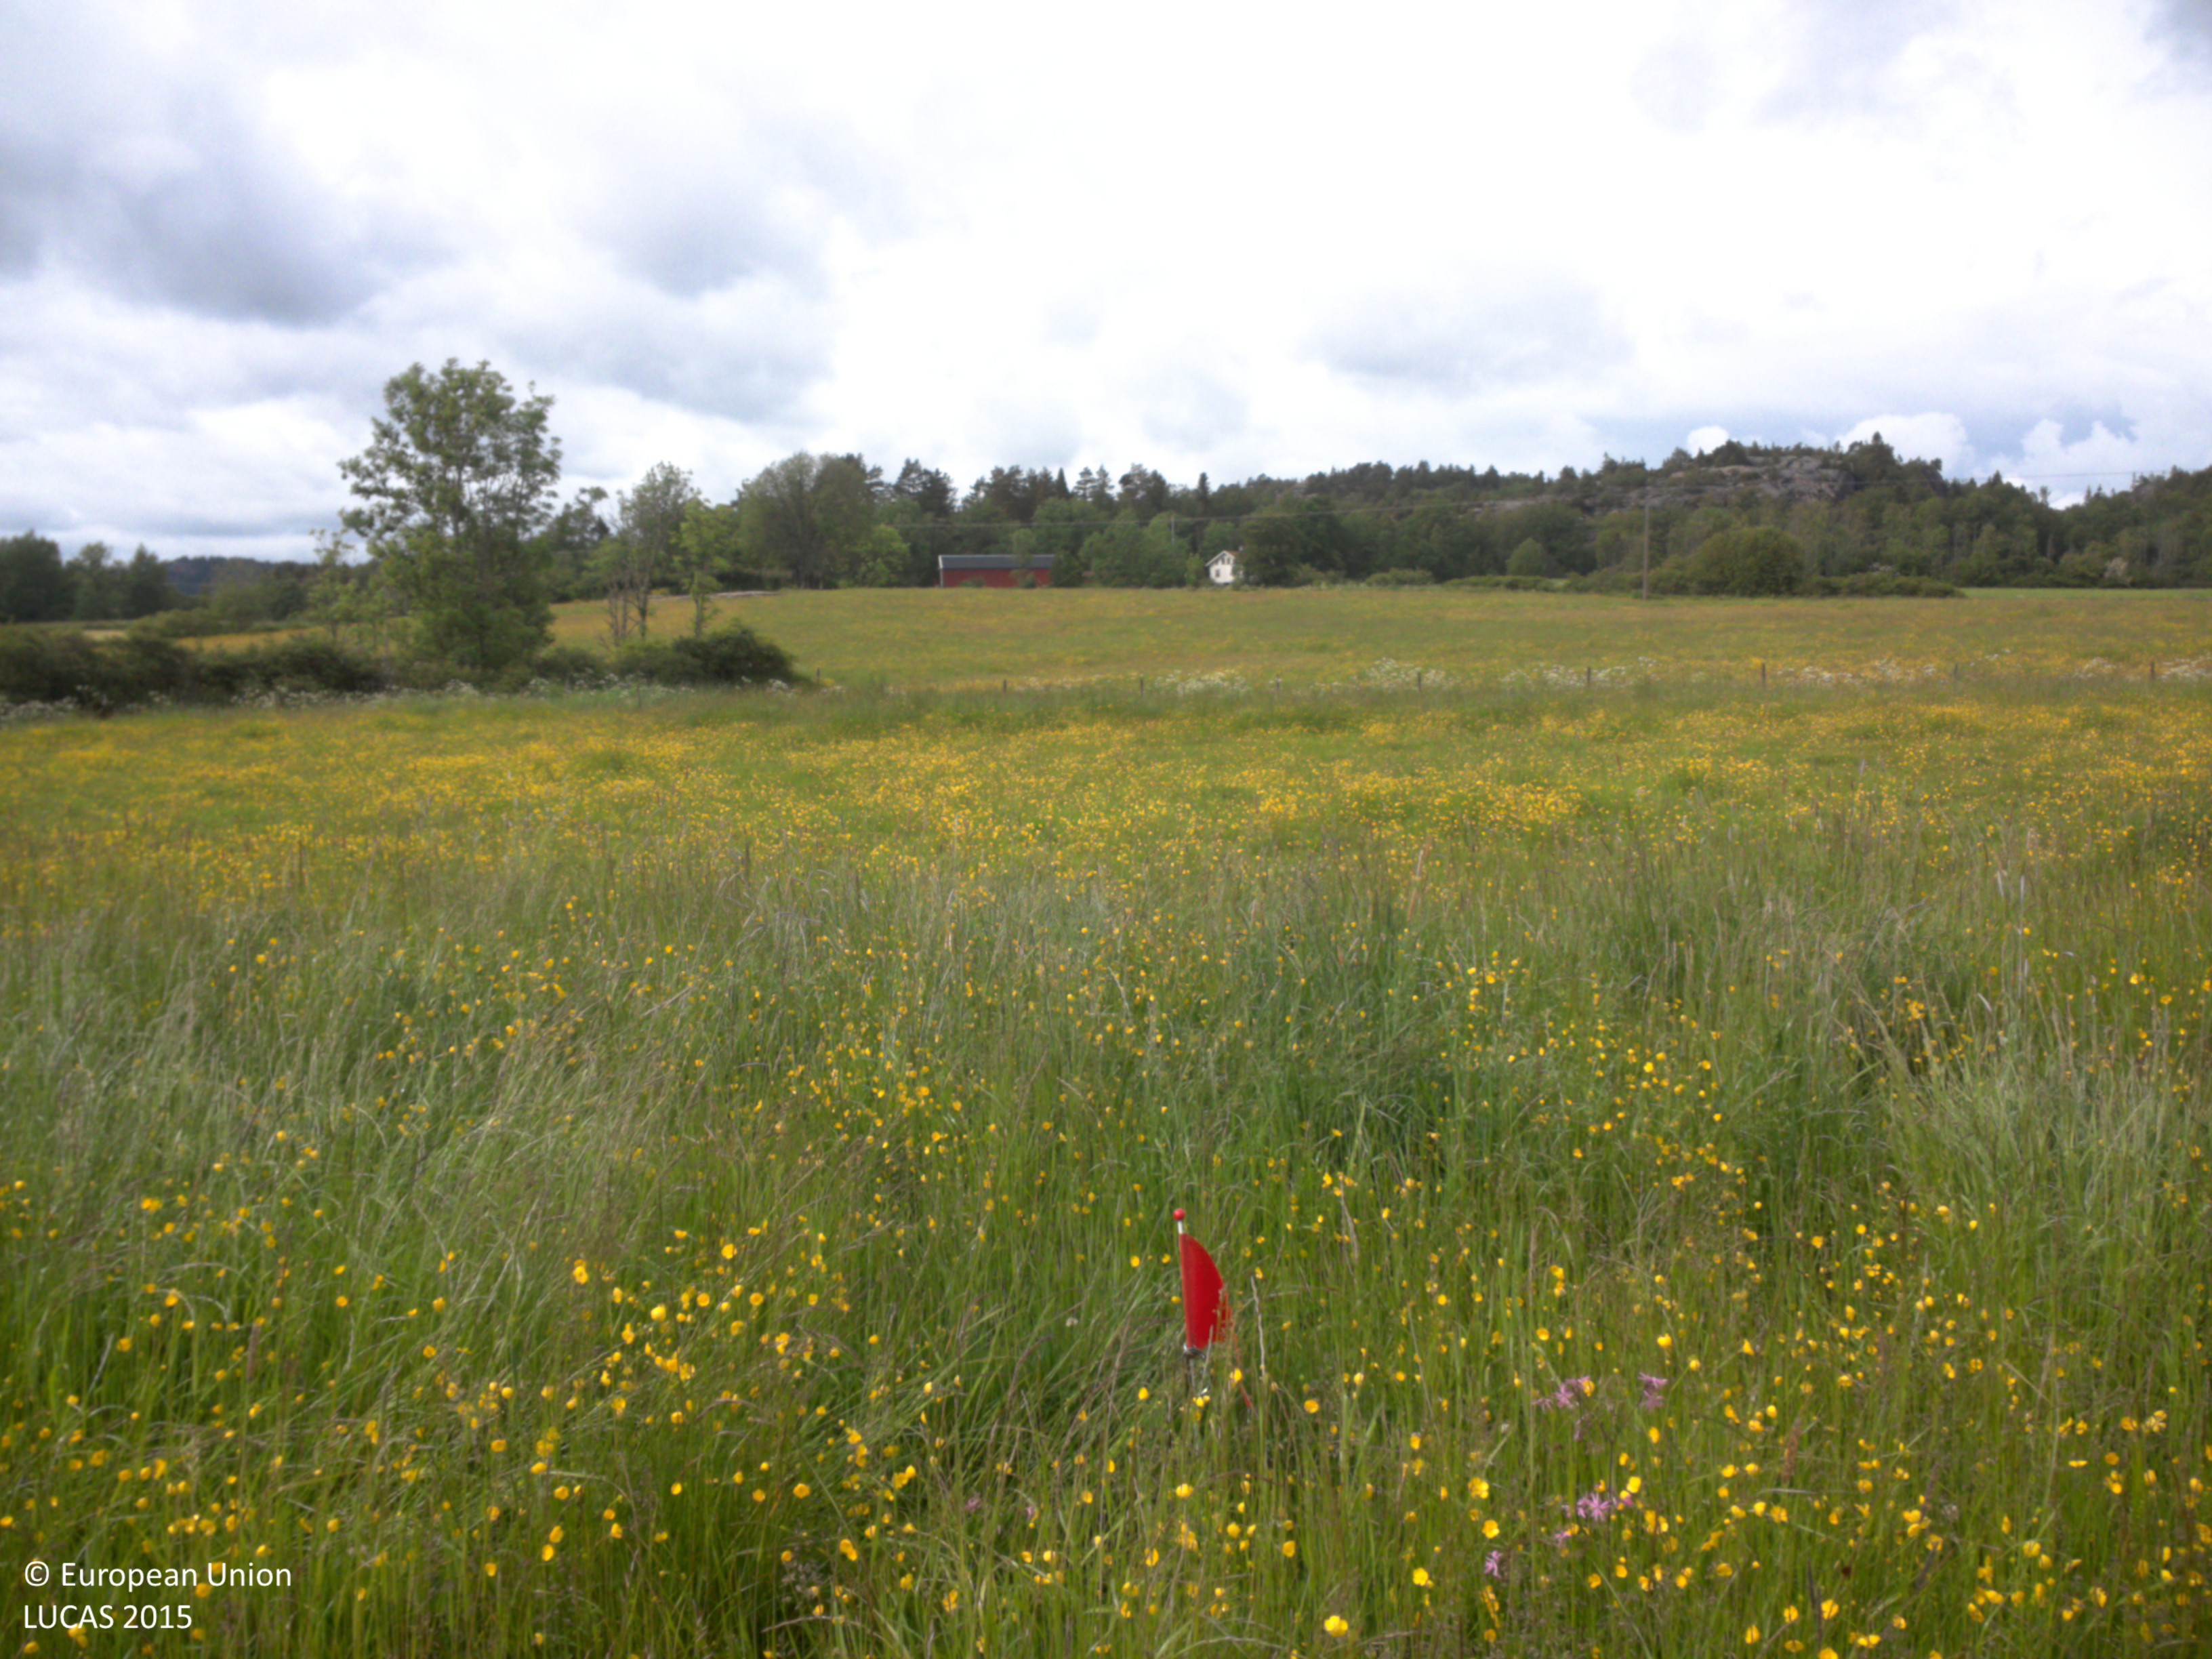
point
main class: Grassland
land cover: Grassland without tree/shrub cover
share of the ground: > 75 %
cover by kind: herbaceous plants 100 %
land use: Agriculture (excluding fallow land and kitchen gardens)
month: June
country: SE
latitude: 58.4447
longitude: 11.5216
